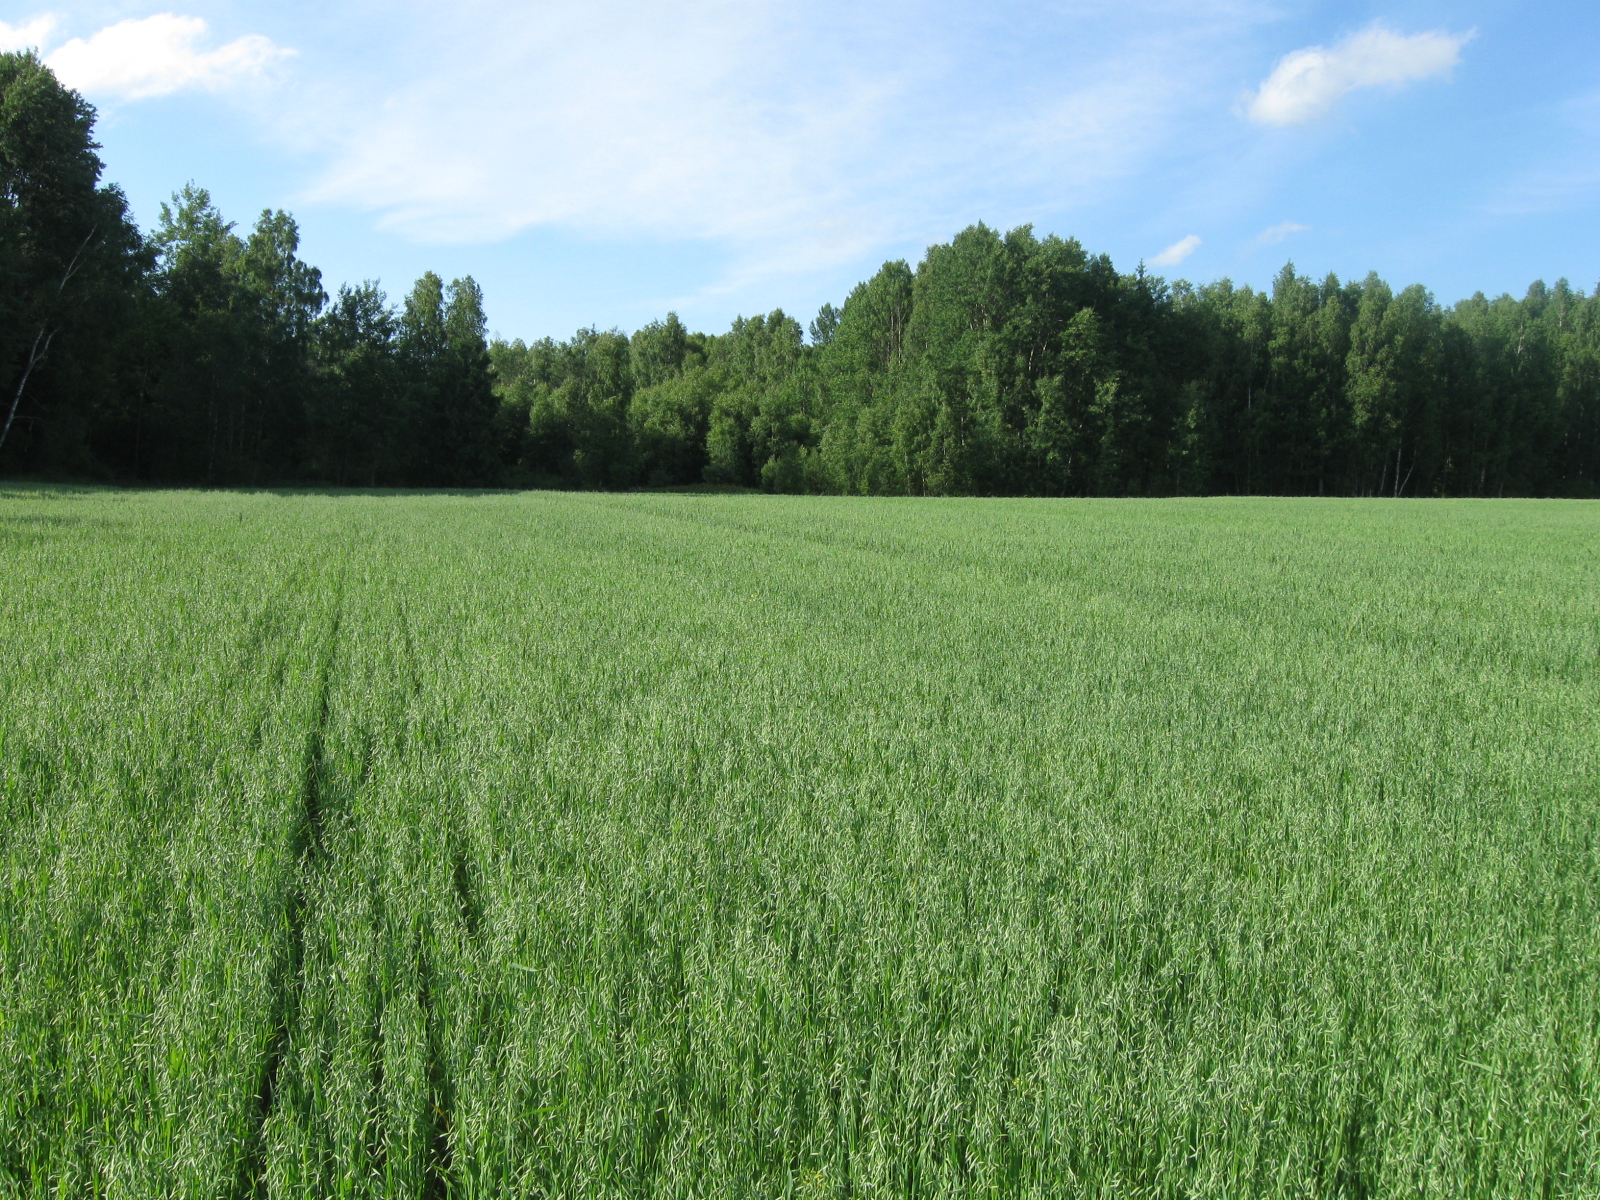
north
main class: Cropland
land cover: Oats
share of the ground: > 75 %
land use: Agriculture (excluding fallow land and kitchen gardens)
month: June
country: LT
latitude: 54.1727
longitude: 24.7704
